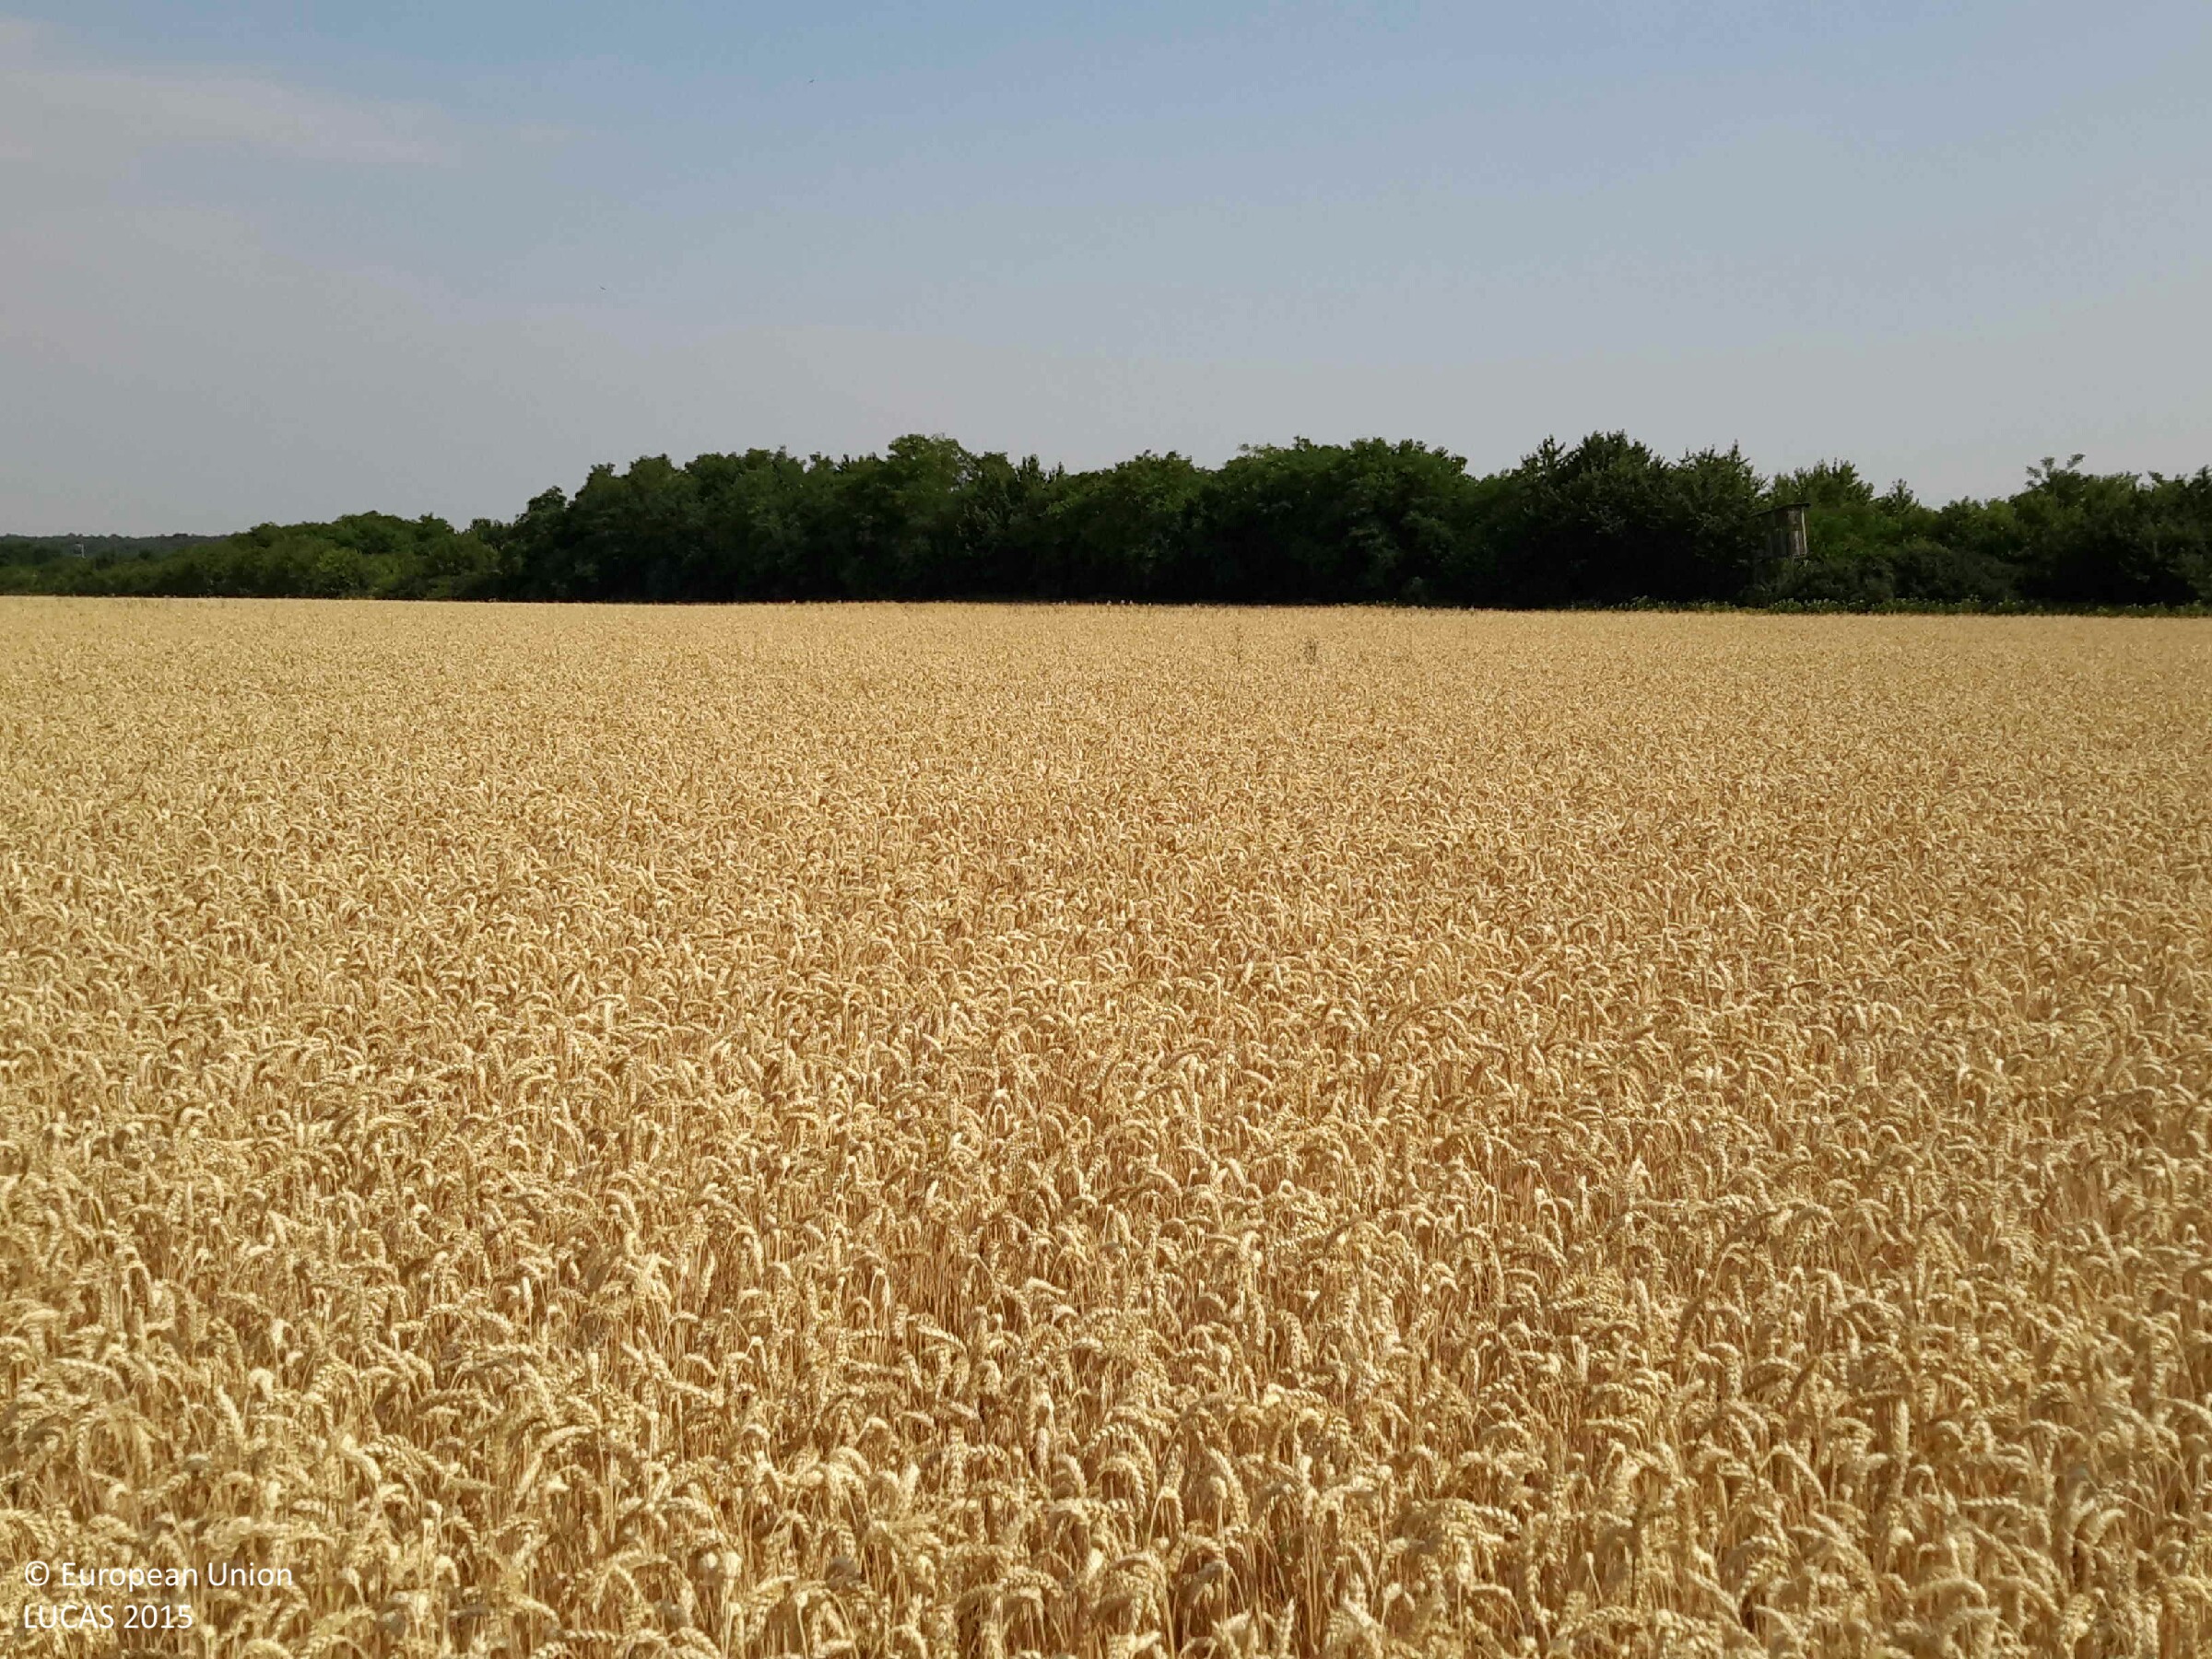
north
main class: Cropland
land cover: Common wheat
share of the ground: > 75 %
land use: Agriculture (excluding fallow land and kitchen gardens)
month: July
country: HU
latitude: 47.6062
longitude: 16.6690
